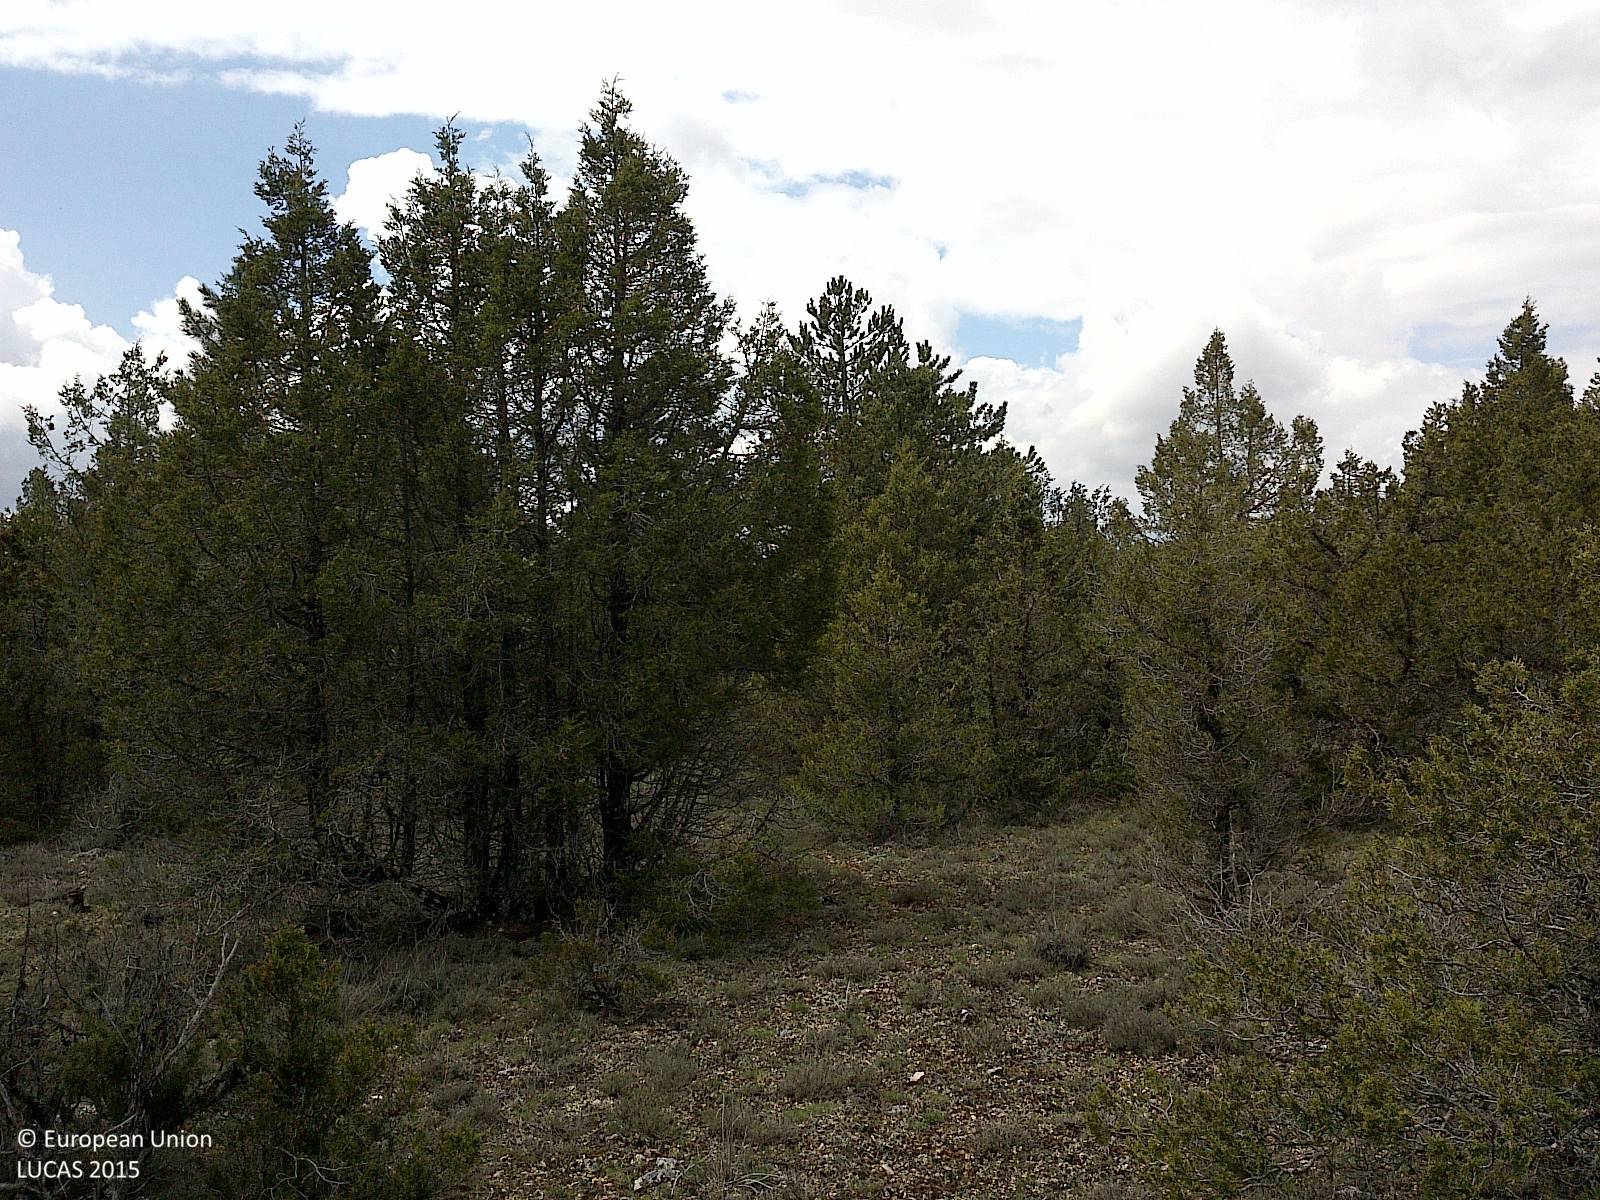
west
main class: Woodland
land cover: Other coniferous woodland
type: coniferous forest of the mediterranean region
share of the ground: 25 - 50 %
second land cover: Grassland without tree/shrub cover
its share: > 75 %
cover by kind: herbaceous plants 65 %, coniferous forest trees 35 %
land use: Forestry
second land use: Agriculture (excluding fallow land and kitchen gardens)
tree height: < 5 m
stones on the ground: 10 - 25 %
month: April
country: ES
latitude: 41.7646
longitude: -2.8043
